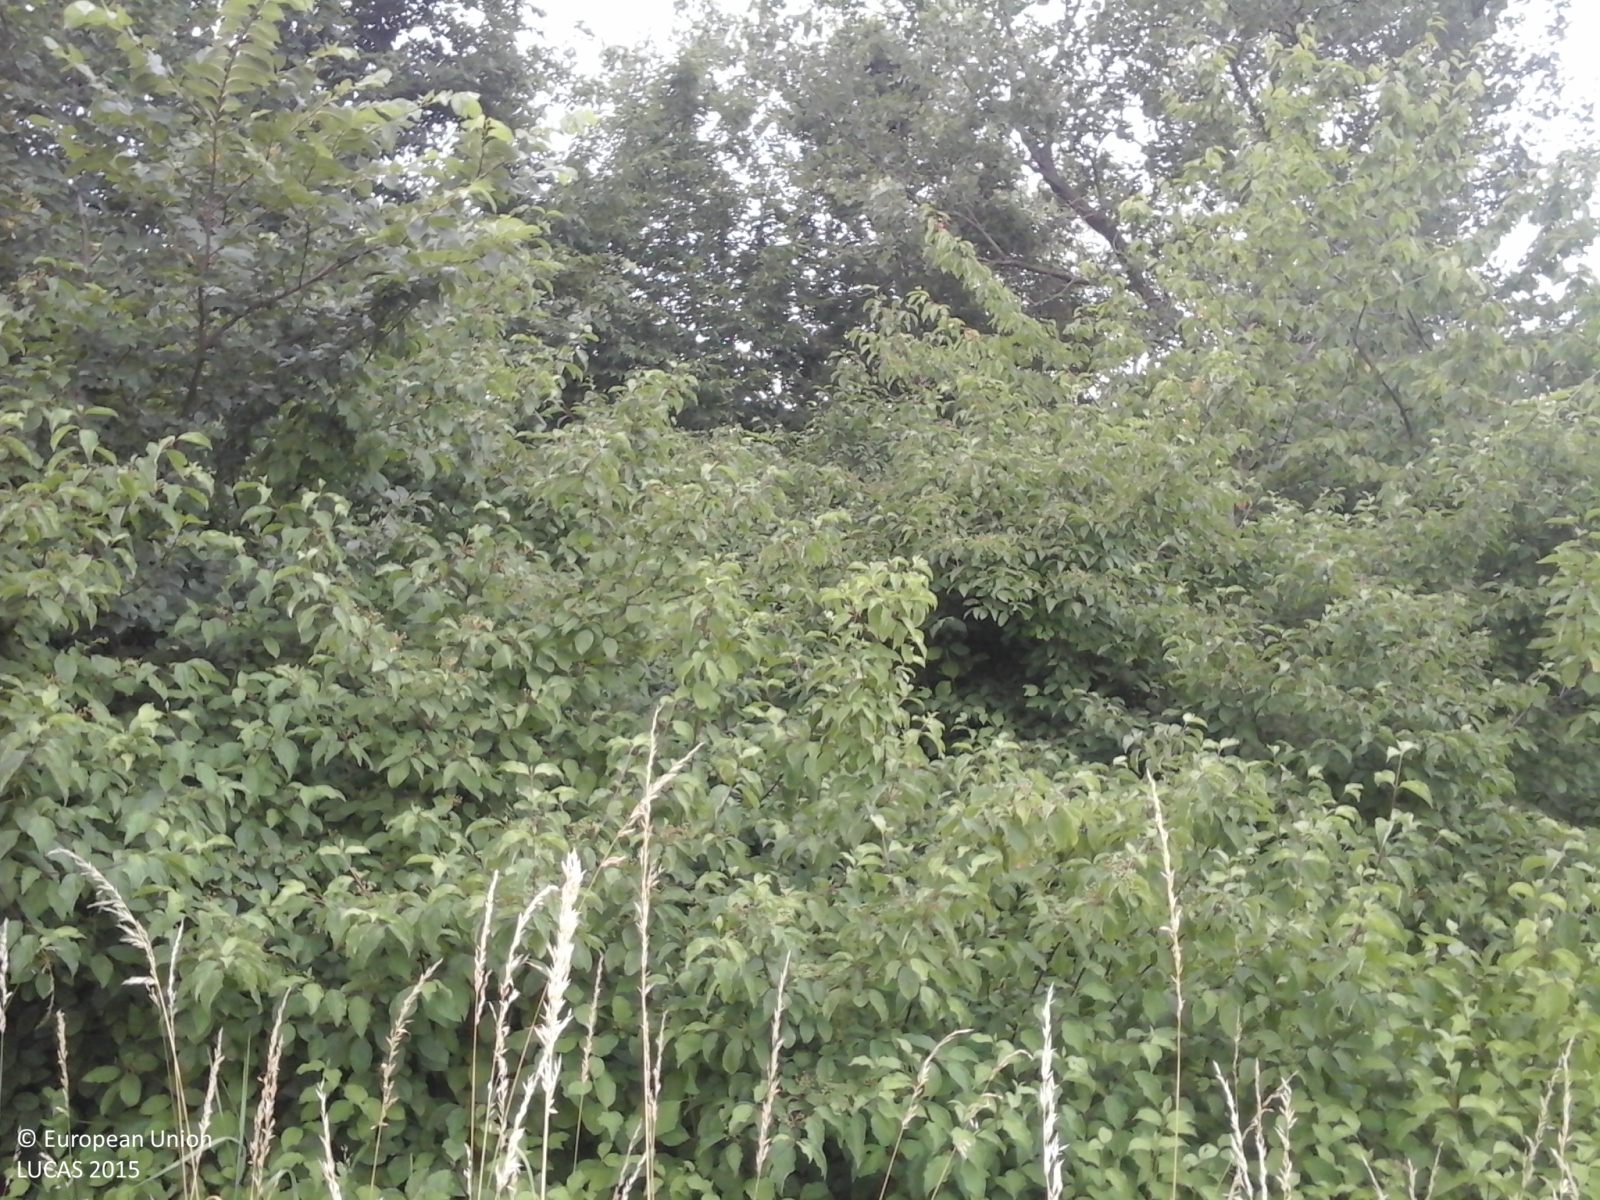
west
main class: Woodland
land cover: Broadleaved woodland
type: thermophilous deciduous forest
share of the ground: > 75 %
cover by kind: broadleaved forest trees 90 %, shrubs 10 %
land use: Forestry
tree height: > 5 m
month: June
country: IT
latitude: 44.6026
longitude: 10.2891
